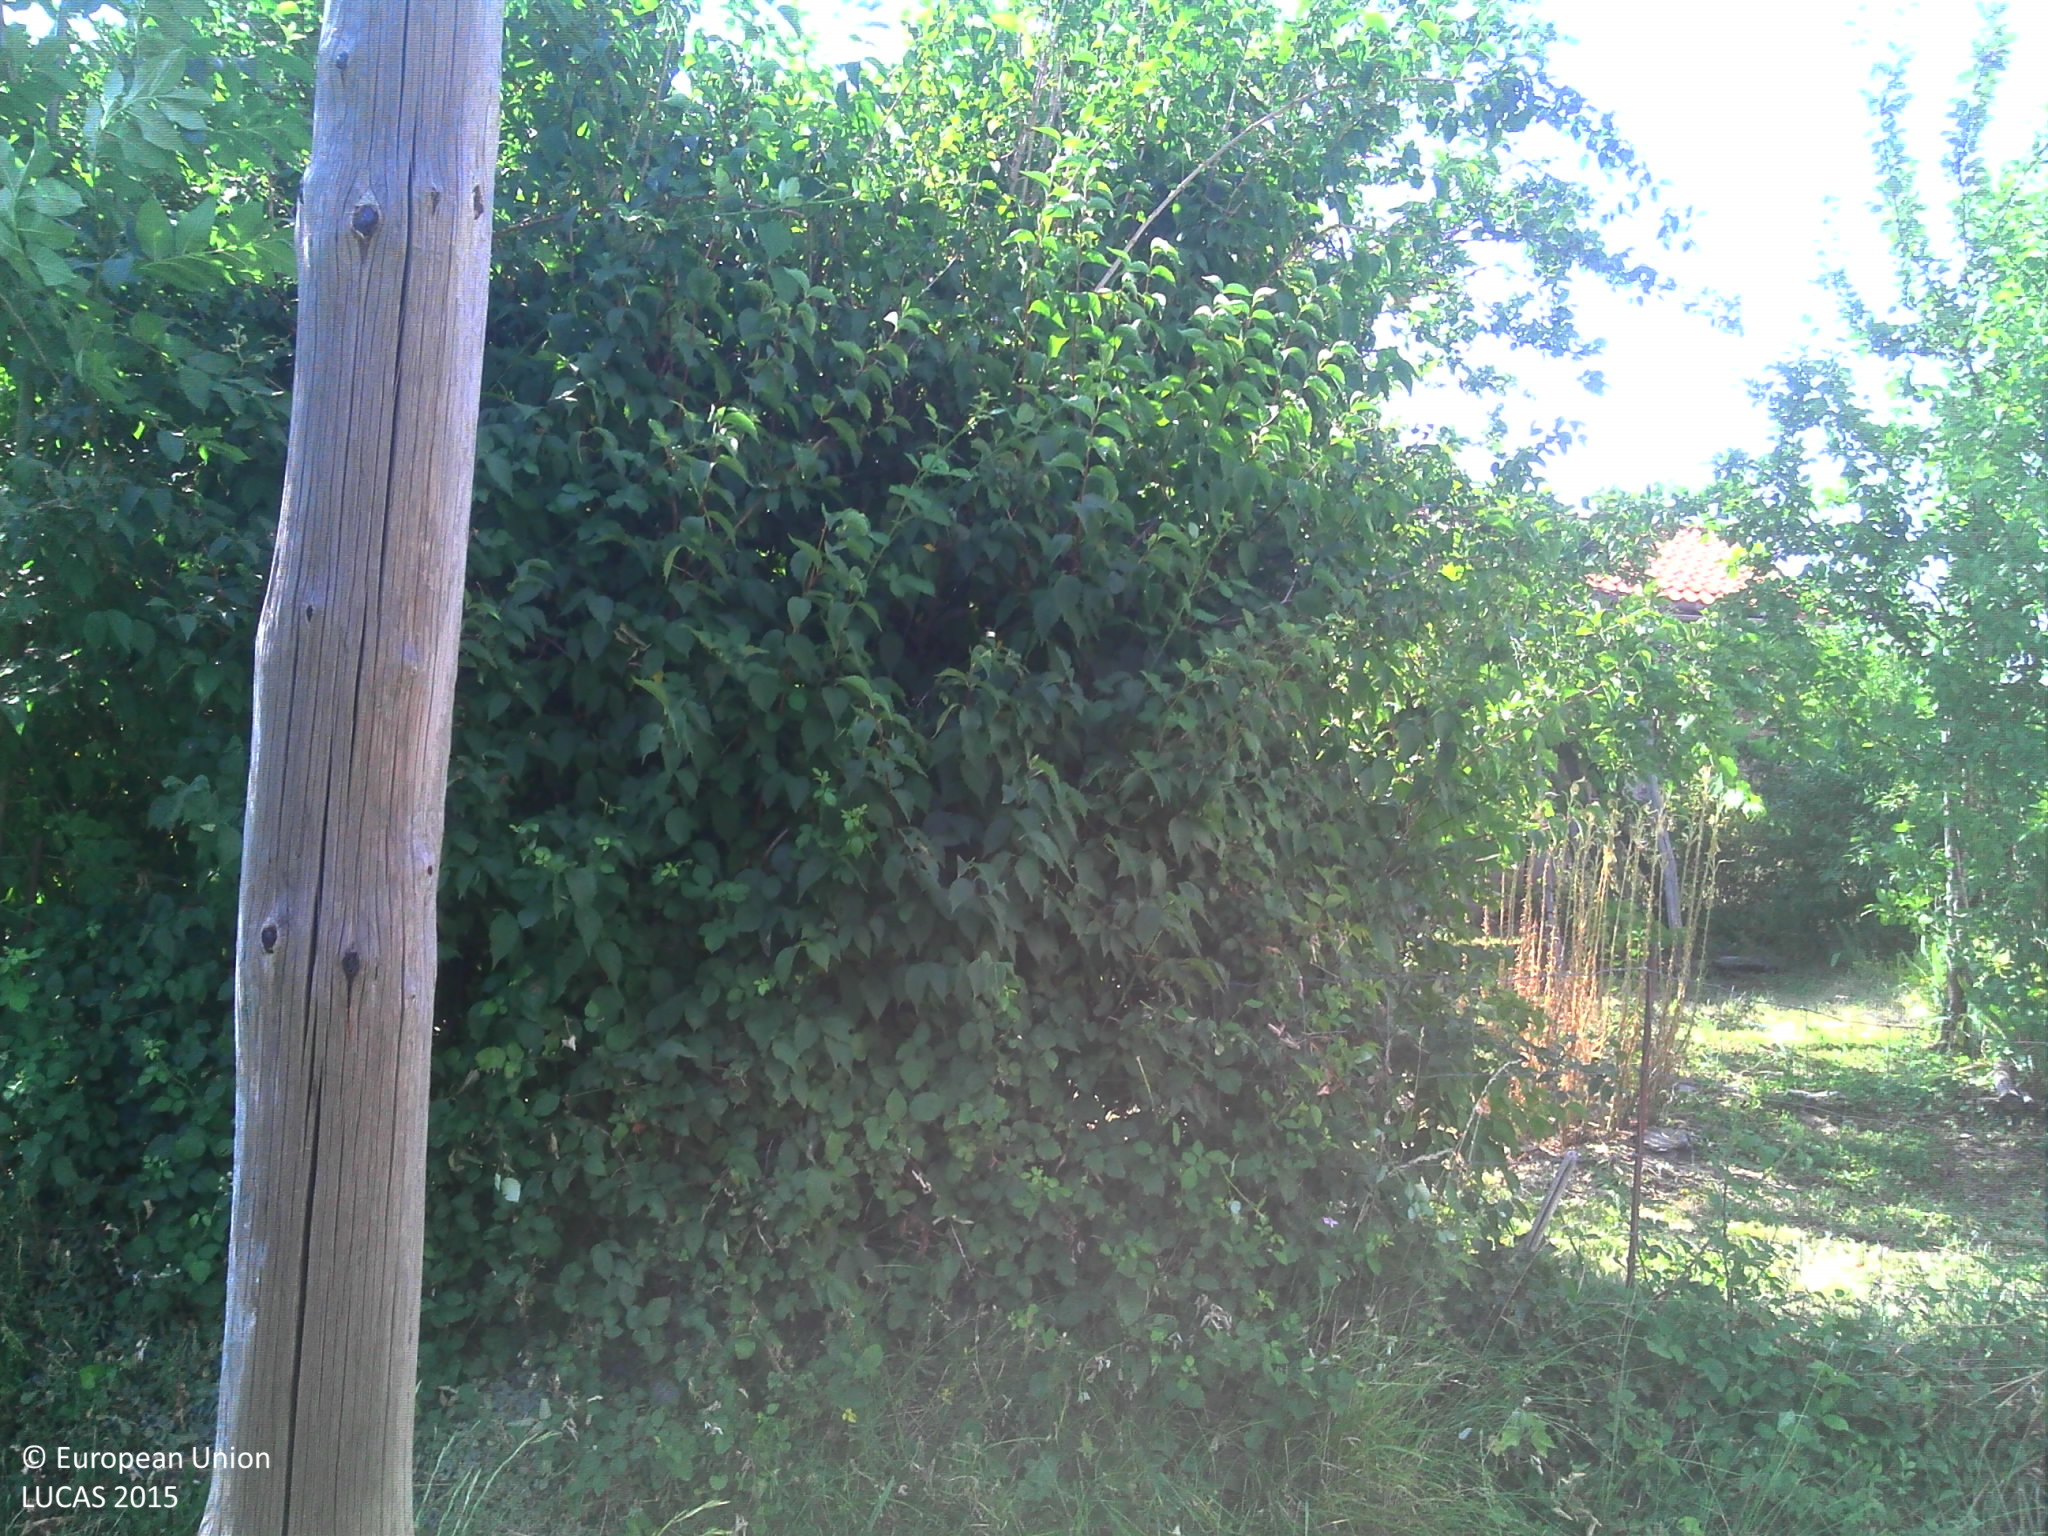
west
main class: Cropland
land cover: Cherry fruit
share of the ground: 25 - 50 %
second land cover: Grassland without tree/shrub cover
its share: 25 - 50 %
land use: Kitchen garden
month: July
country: FR
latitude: 44.2274
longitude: 3.9354
